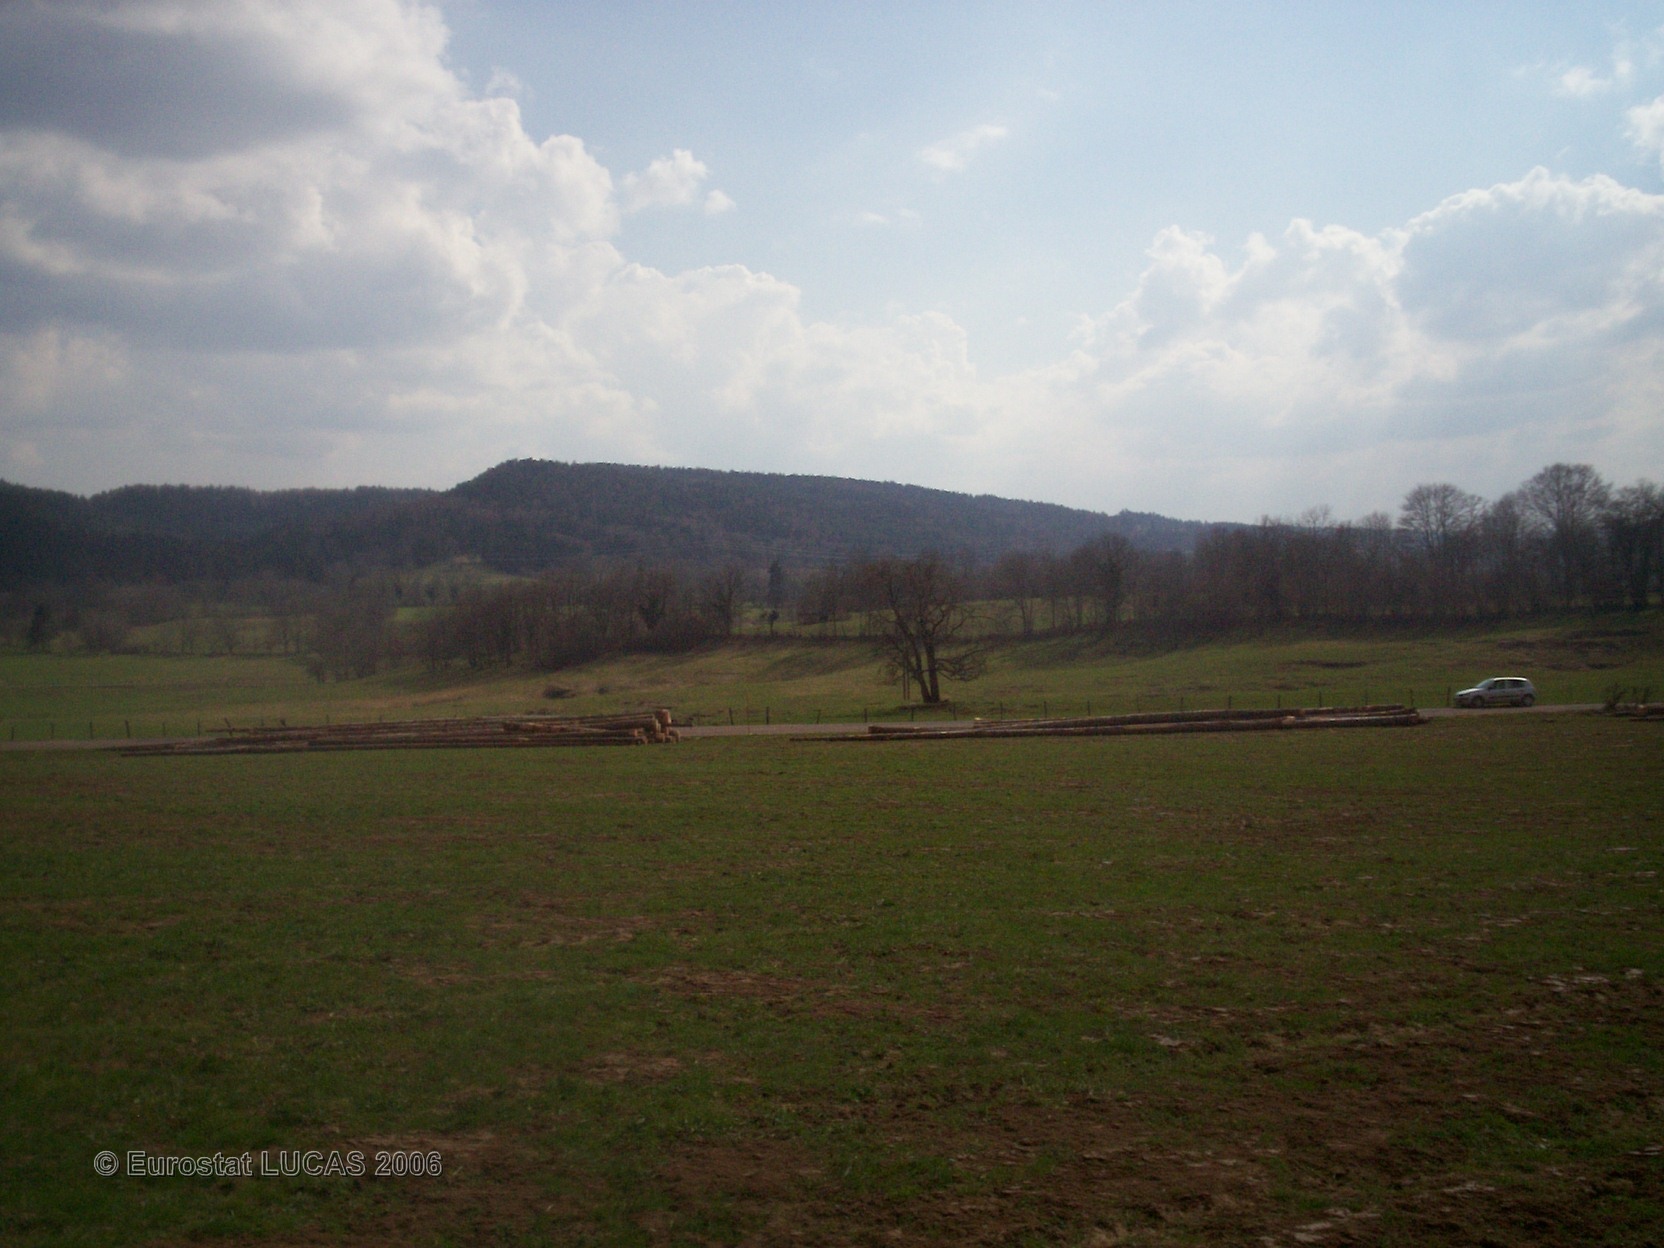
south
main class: Grassland
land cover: Grassland without tree/shrub cover
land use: Agriculture (excluding fallow land and kitchen gardens)
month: April
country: FR
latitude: 47.3160
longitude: 6.9195
